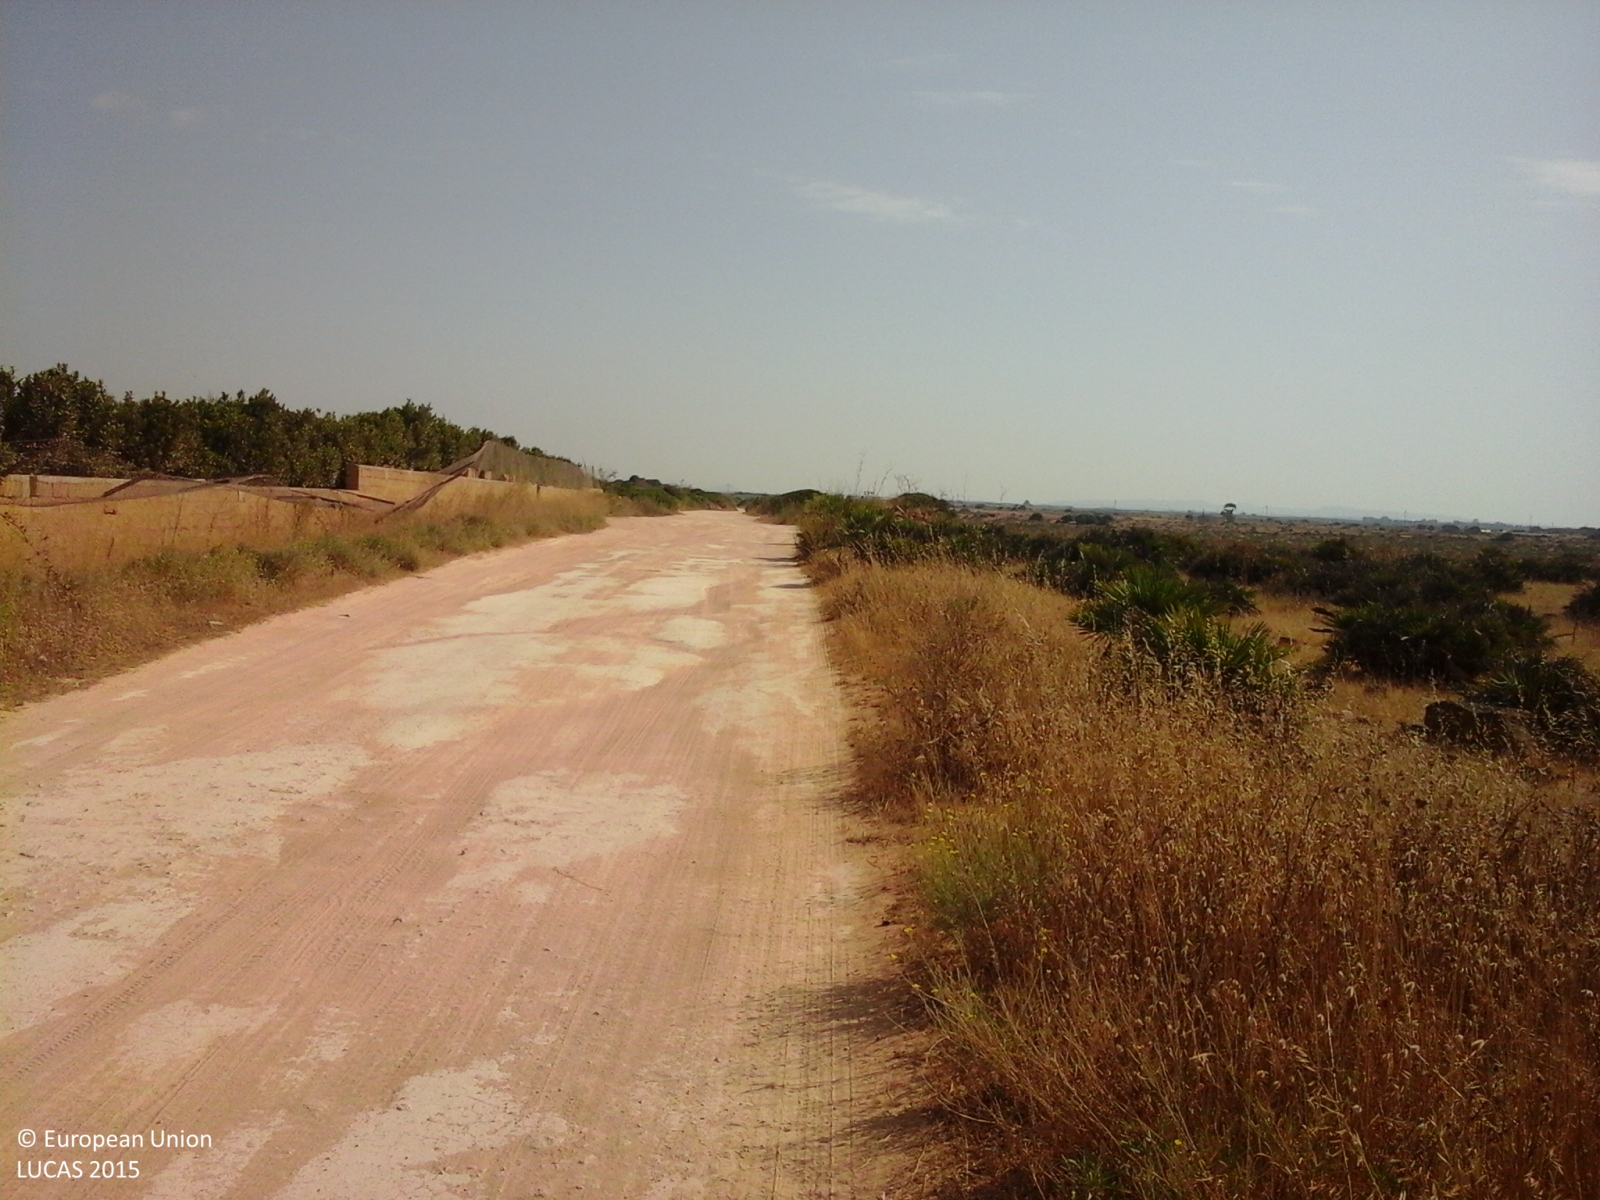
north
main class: Cropland
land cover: Other fresh vegetables
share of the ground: > 75 %
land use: Agriculture (excluding fallow land and kitchen gardens)
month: May
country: IT
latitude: 37.5831
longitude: 12.6633
